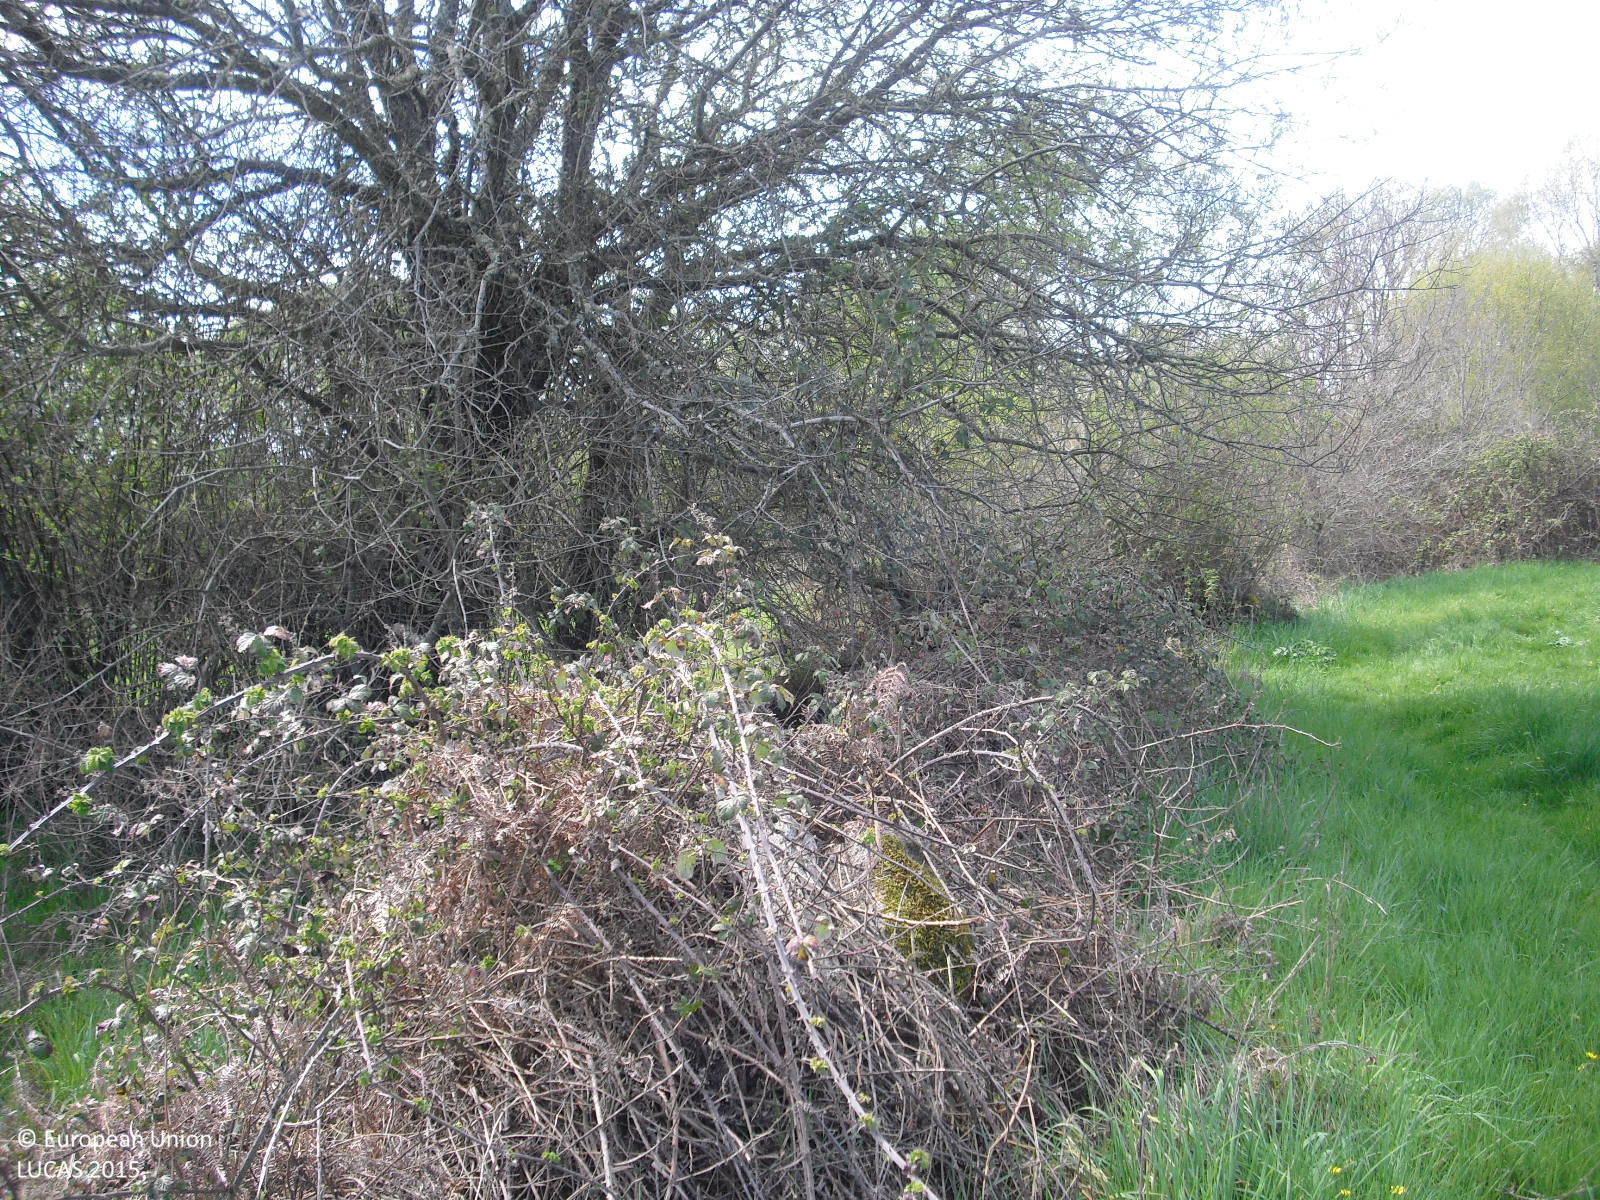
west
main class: Grassland
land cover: Grassland without tree/shrub cover
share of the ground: > 75 %
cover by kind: herbaceous plants 100 %
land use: Agriculture (excluding fallow land and kitchen gardens)
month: April
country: ES
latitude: 41.9978
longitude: -7.8299
